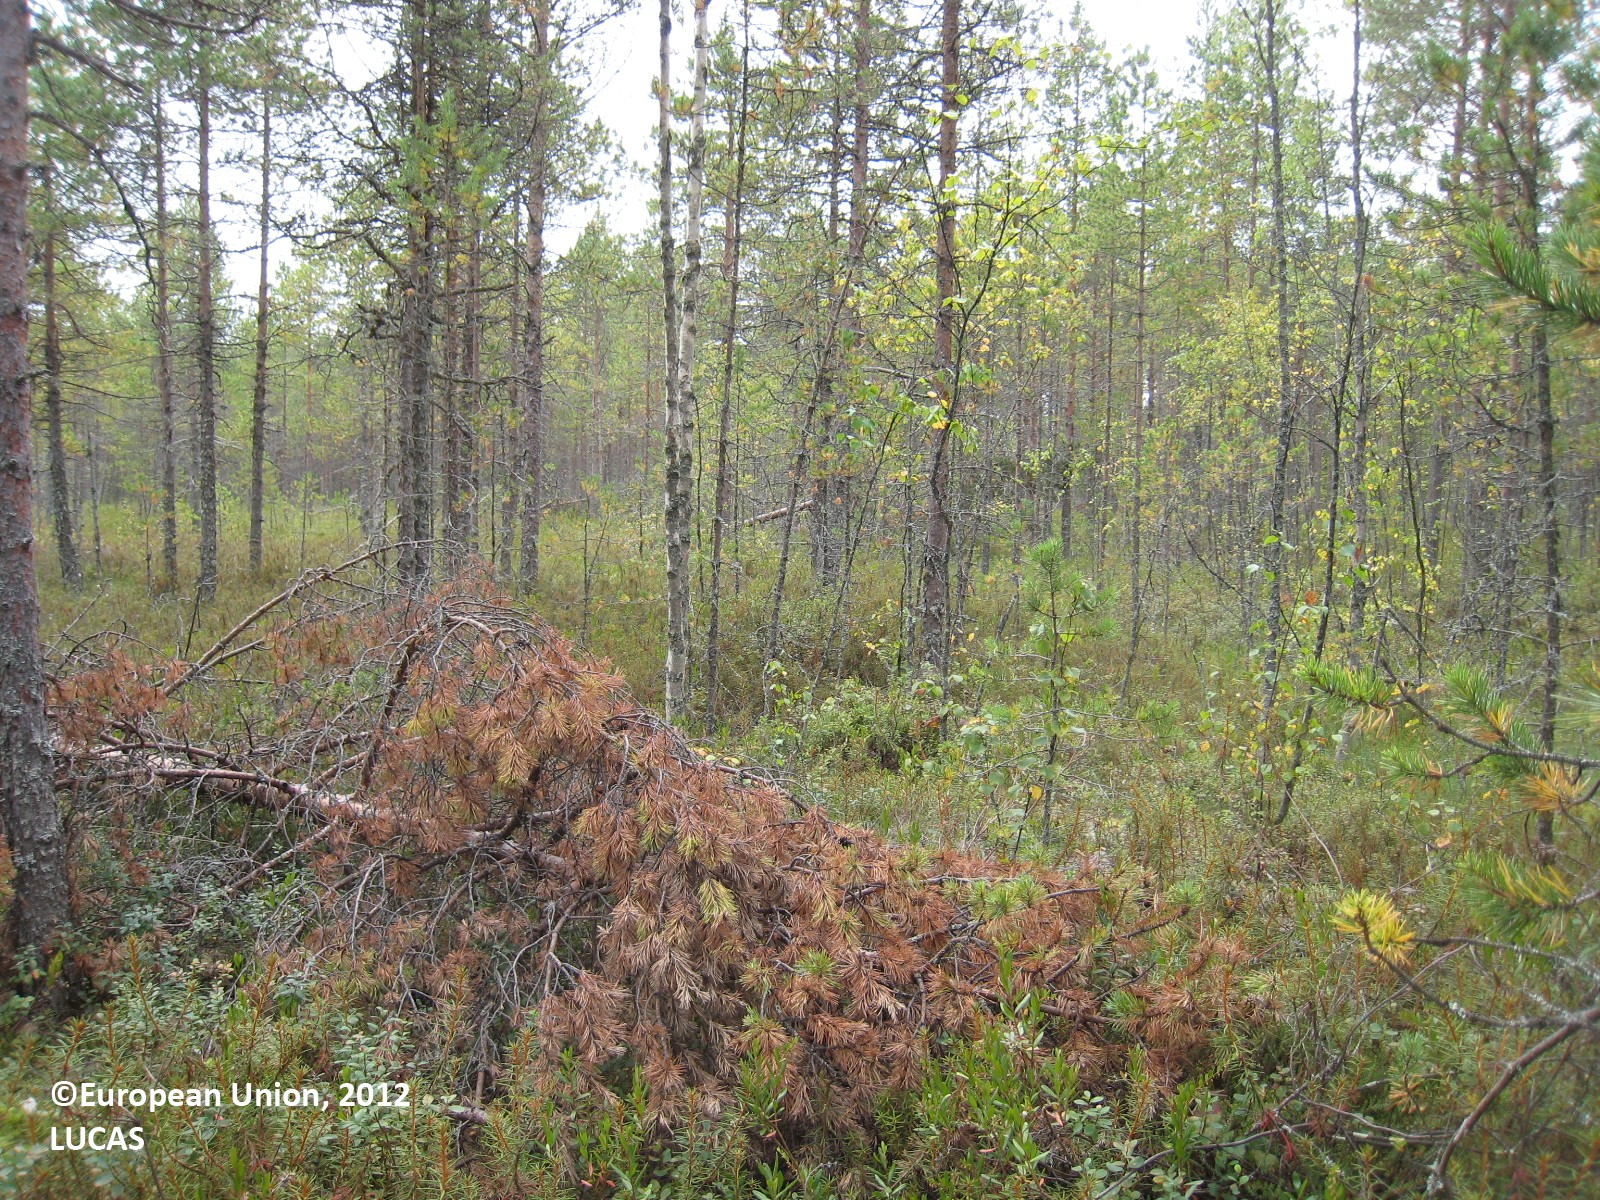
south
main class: Woodland
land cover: Pine dominated coniferous woodland
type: mire and swamp forests
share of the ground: 50 - 75 %
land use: Forestry
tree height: > 5 m
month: August
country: FI
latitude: 62.3633
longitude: 27.2632
